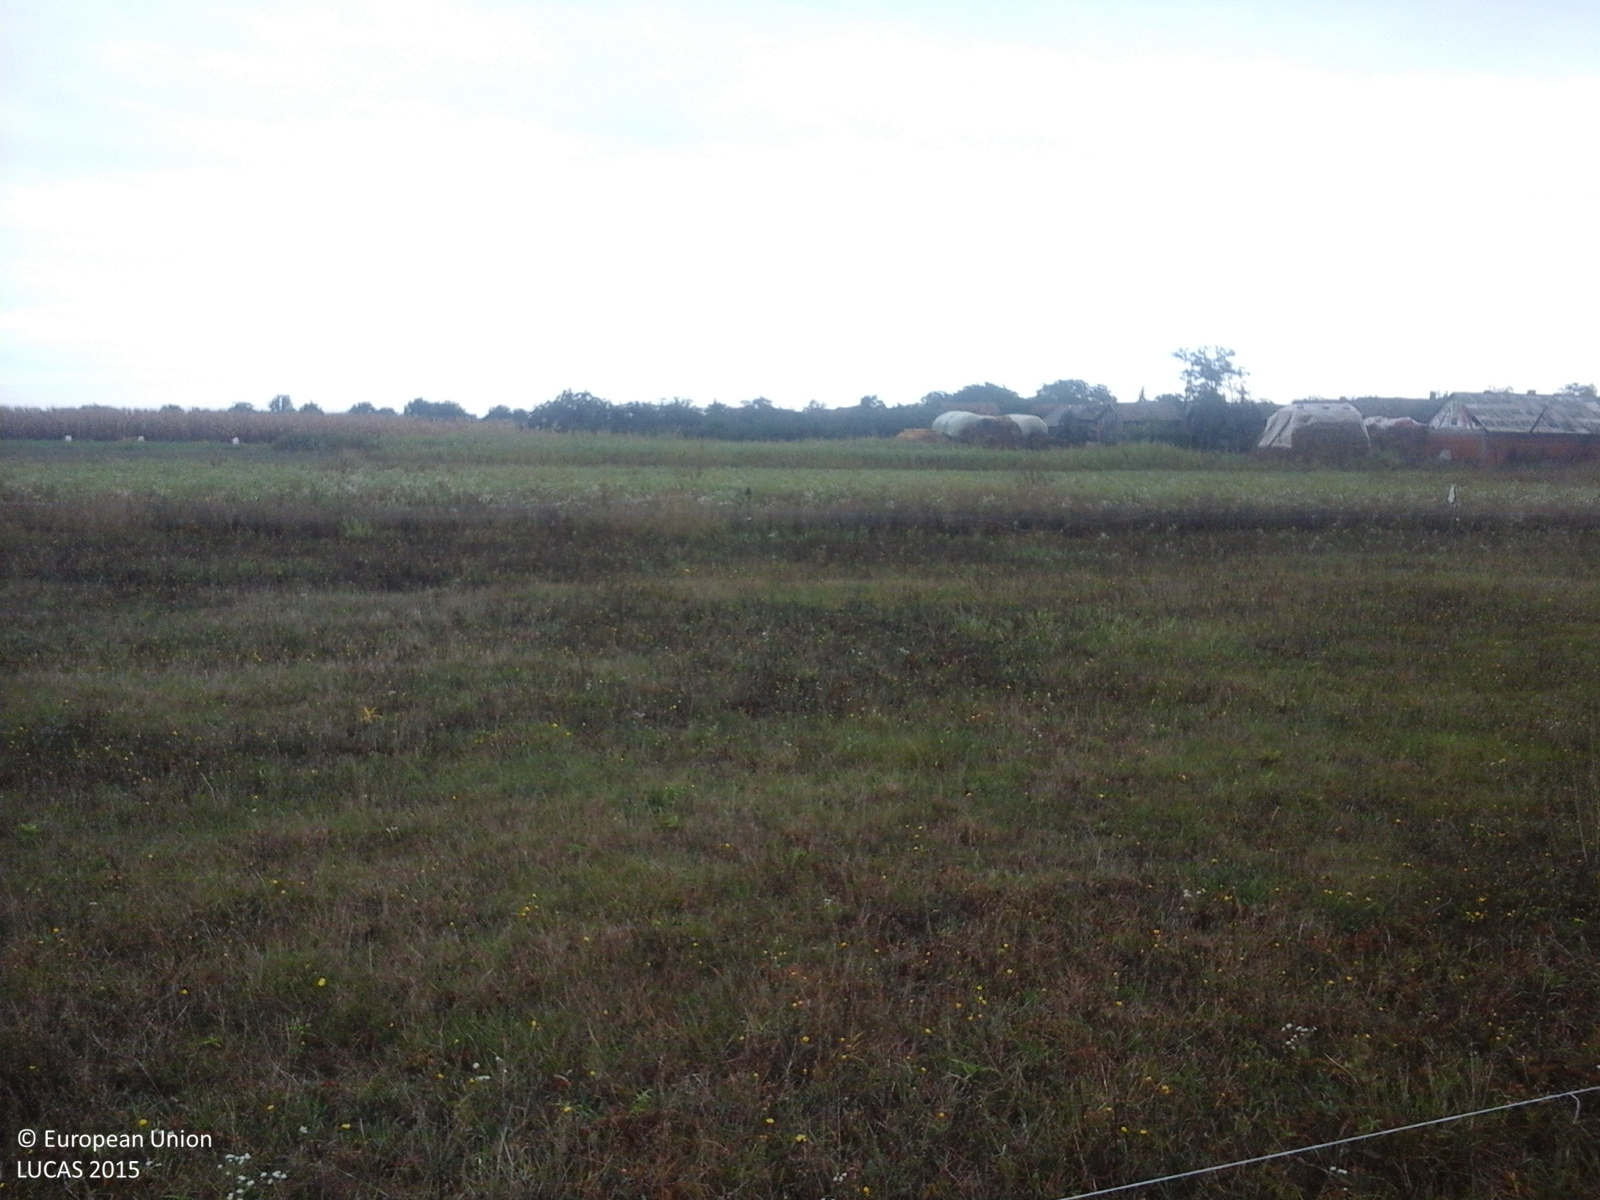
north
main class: Grassland
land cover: Spontaneously vegetated surfaces
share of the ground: > 75 %
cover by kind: herbaceous plants 100 %
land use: Agriculture (excluding fallow land and kitchen gardens)
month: September
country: RO
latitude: 47.2343
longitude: 21.8683
